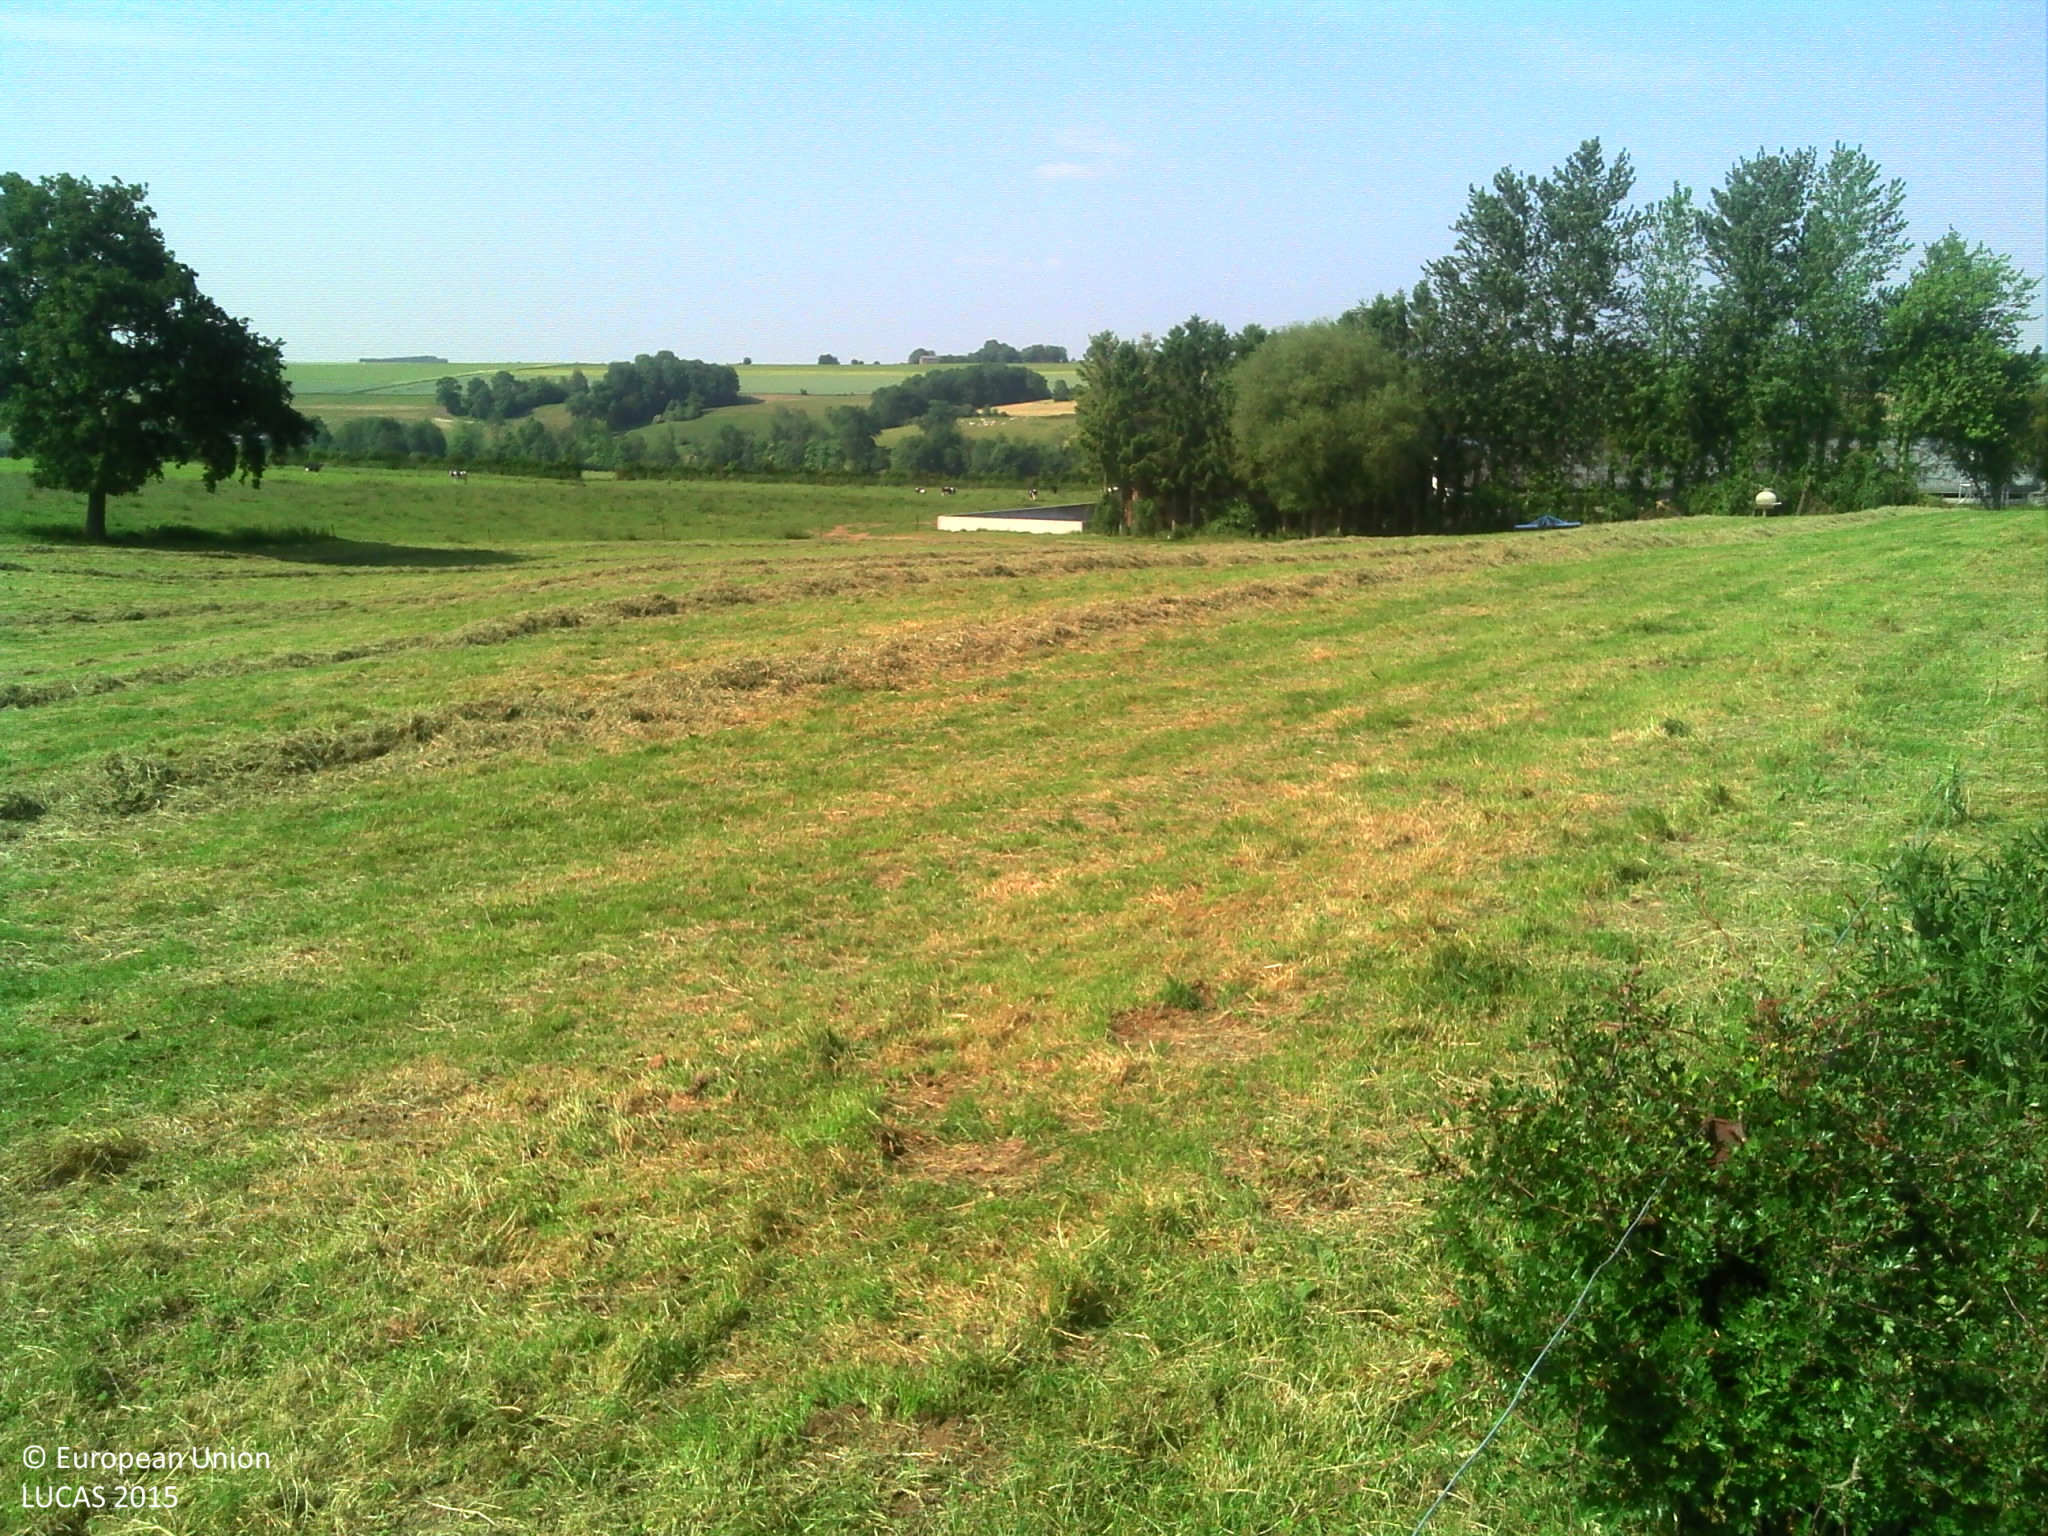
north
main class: Grassland
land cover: Grassland without tree/shrub cover
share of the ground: > 75 %
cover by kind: herbaceous plants 100 %
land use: Agriculture (excluding fallow land and kitchen gardens)
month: June
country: FR
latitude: 49.7593
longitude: 4.0673
